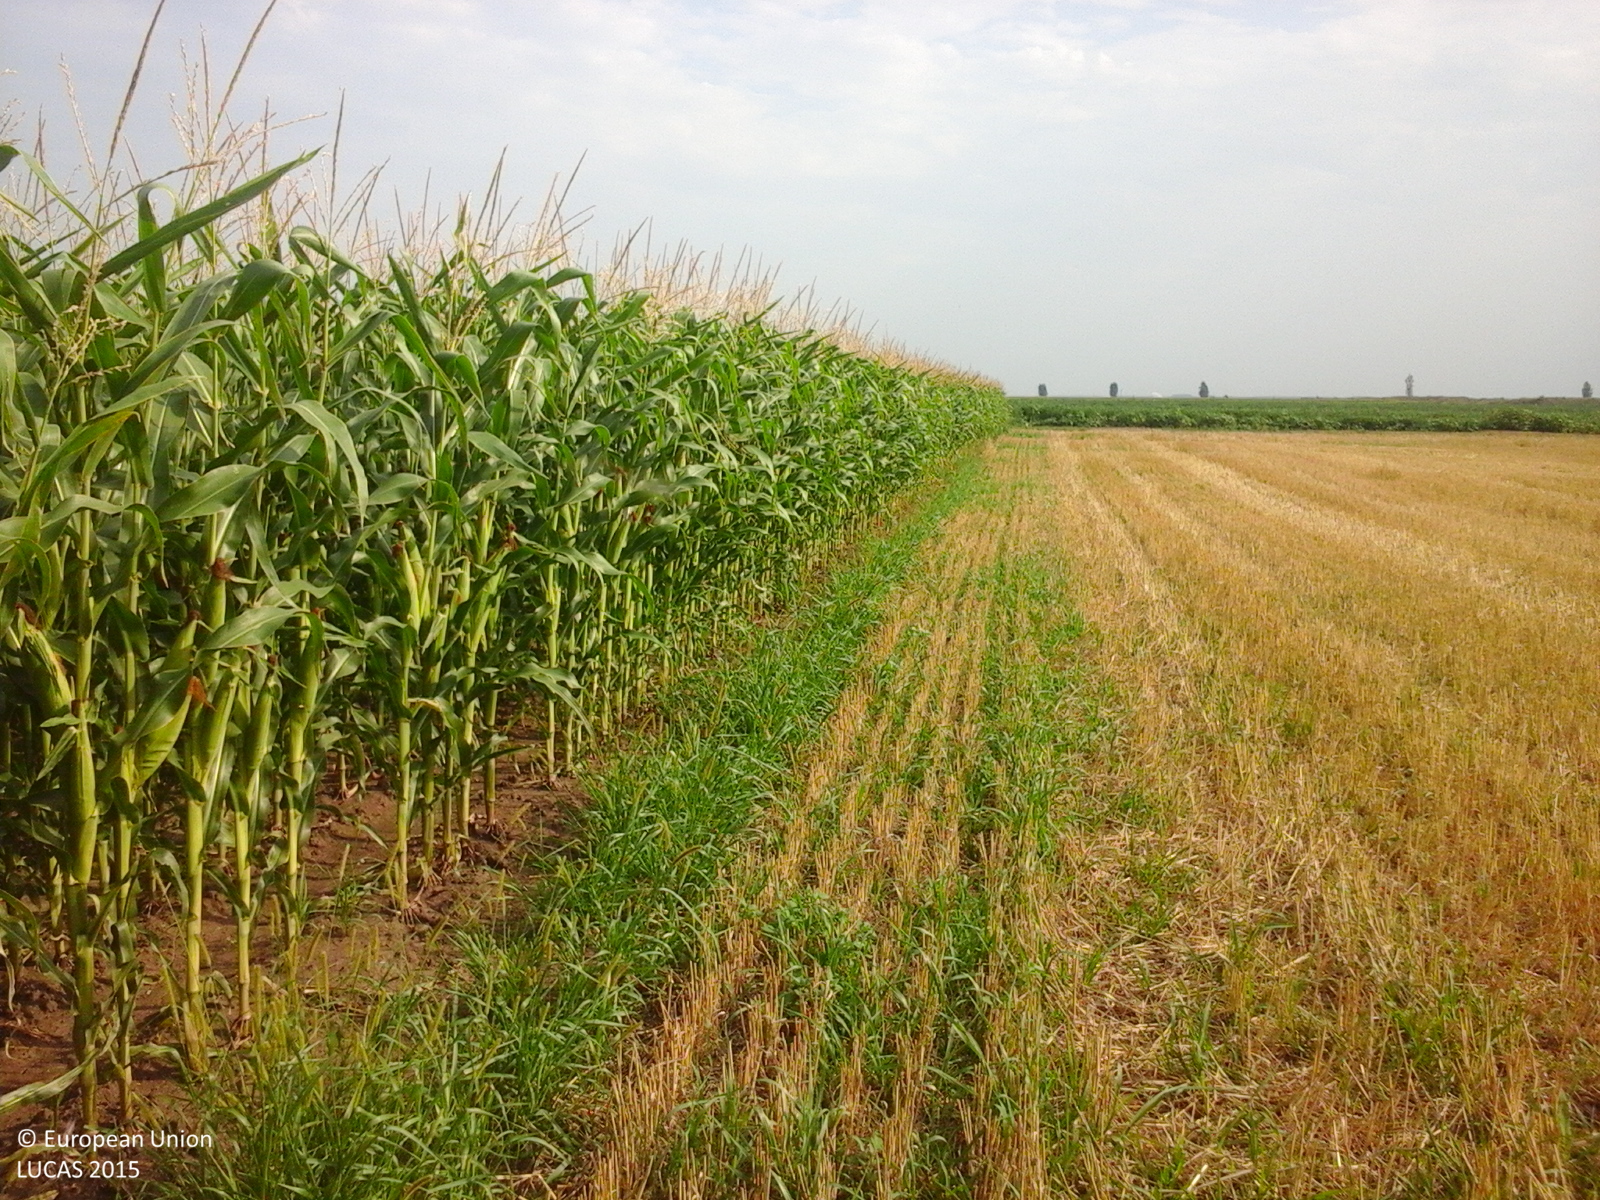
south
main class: Cropland
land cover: Maize
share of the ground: > 75 %
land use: Agriculture (excluding fallow land and kitchen gardens)
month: August
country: RO
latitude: 45.0504
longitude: 27.6629
